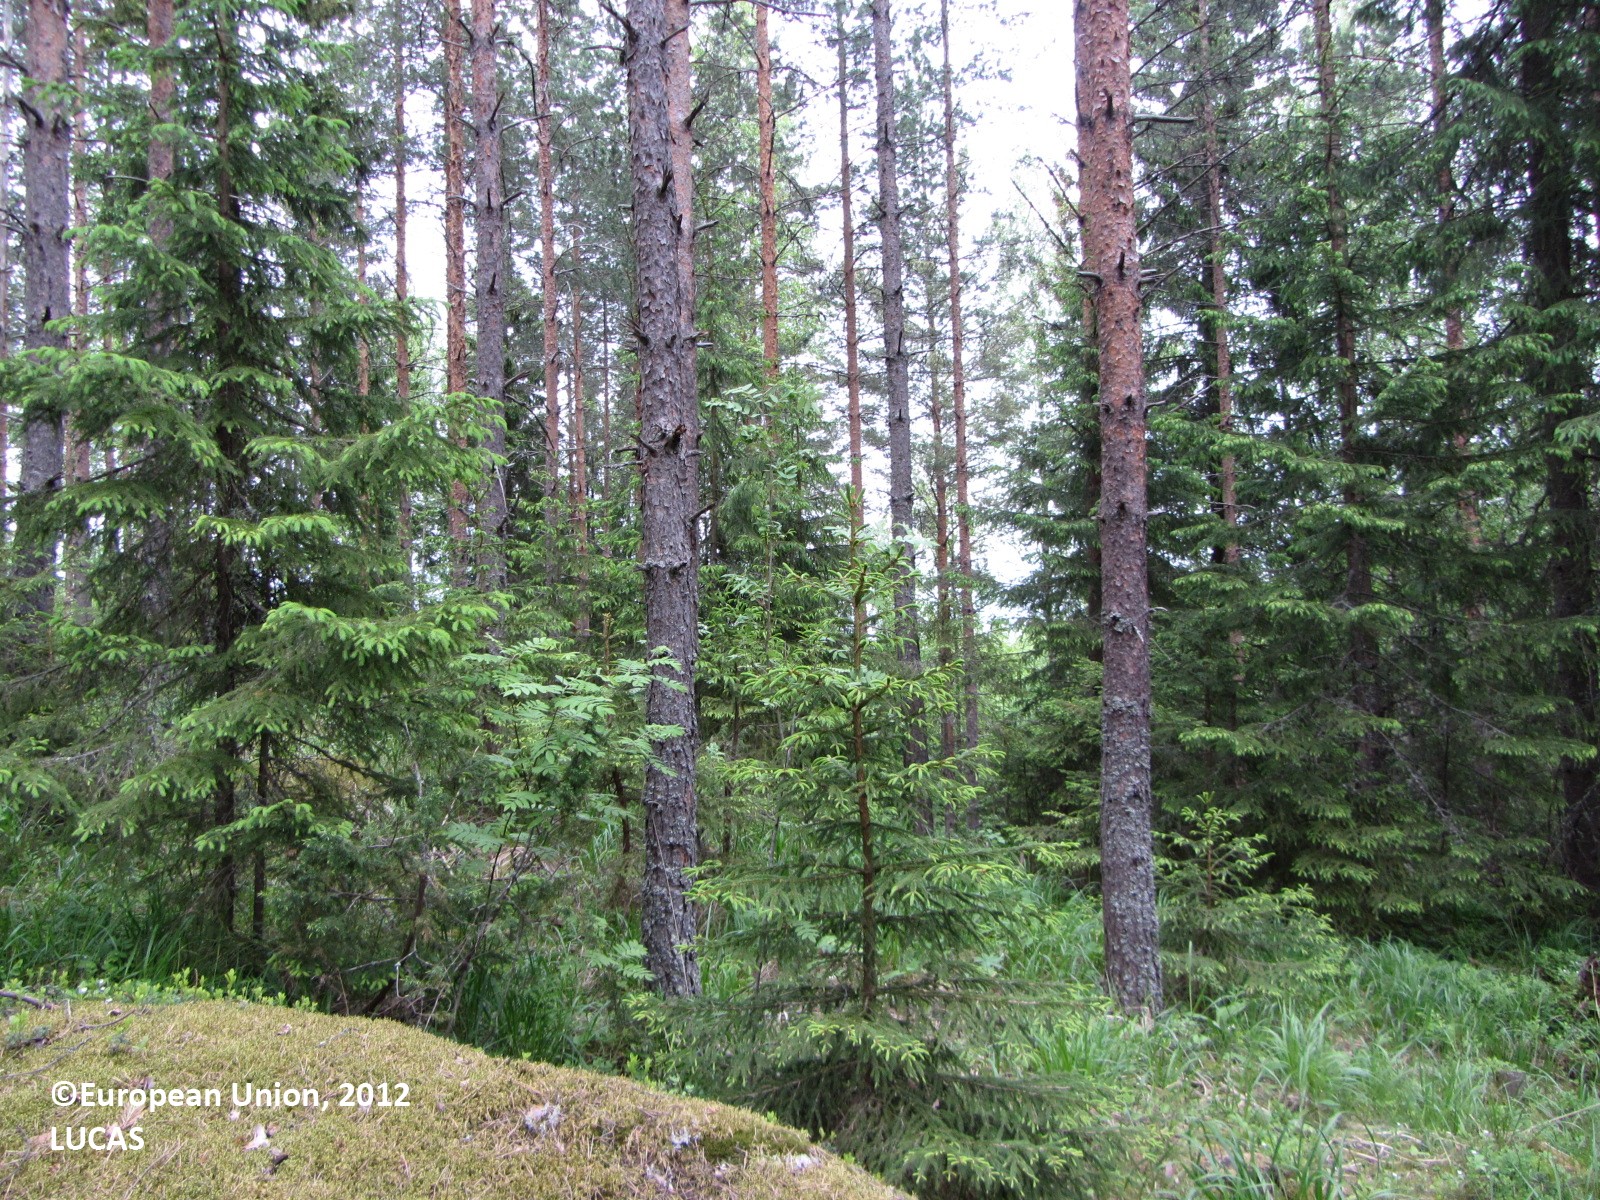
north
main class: Woodland
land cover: Other coniferous woodland
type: hemiboreal forest and nemoral coniferous forest and mixed broadleaved-coniferous forest
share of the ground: > 75 %
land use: Forestry
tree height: > 5 m
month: June
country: FI
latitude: 61.7394
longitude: 25.0460
